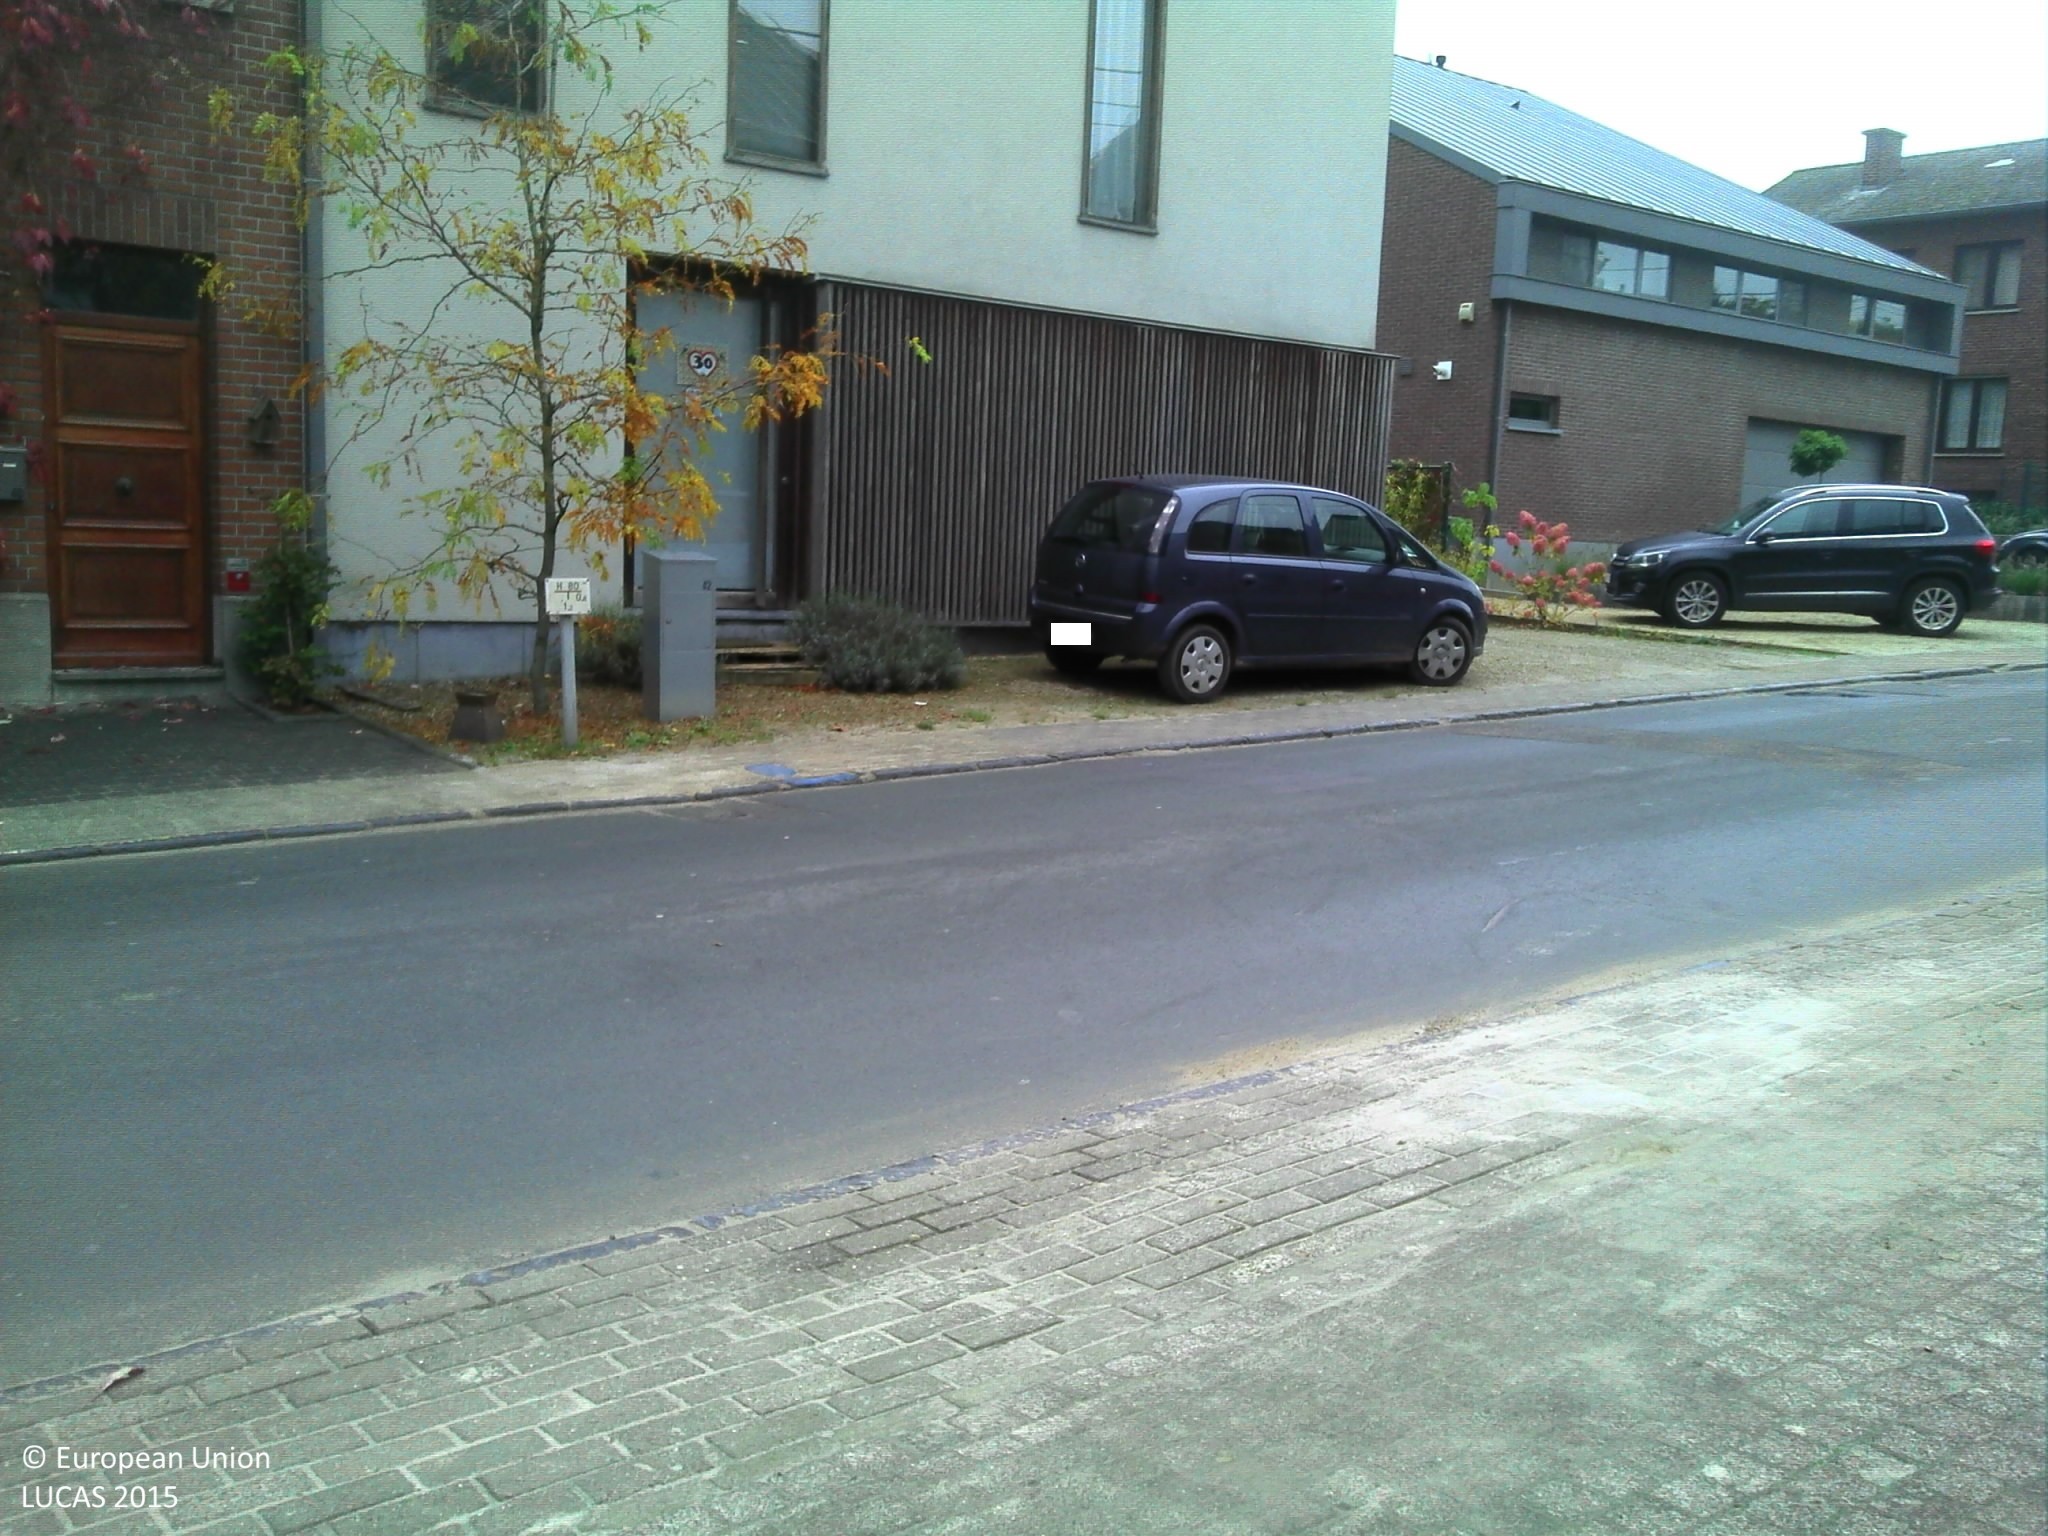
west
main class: Grassland
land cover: Grassland without tree/shrub cover
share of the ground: > 75 %
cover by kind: herbaceous plants 95 %, shrubs 5 %
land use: Residential
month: October
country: BE
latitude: 50.8485
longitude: 4.5845
